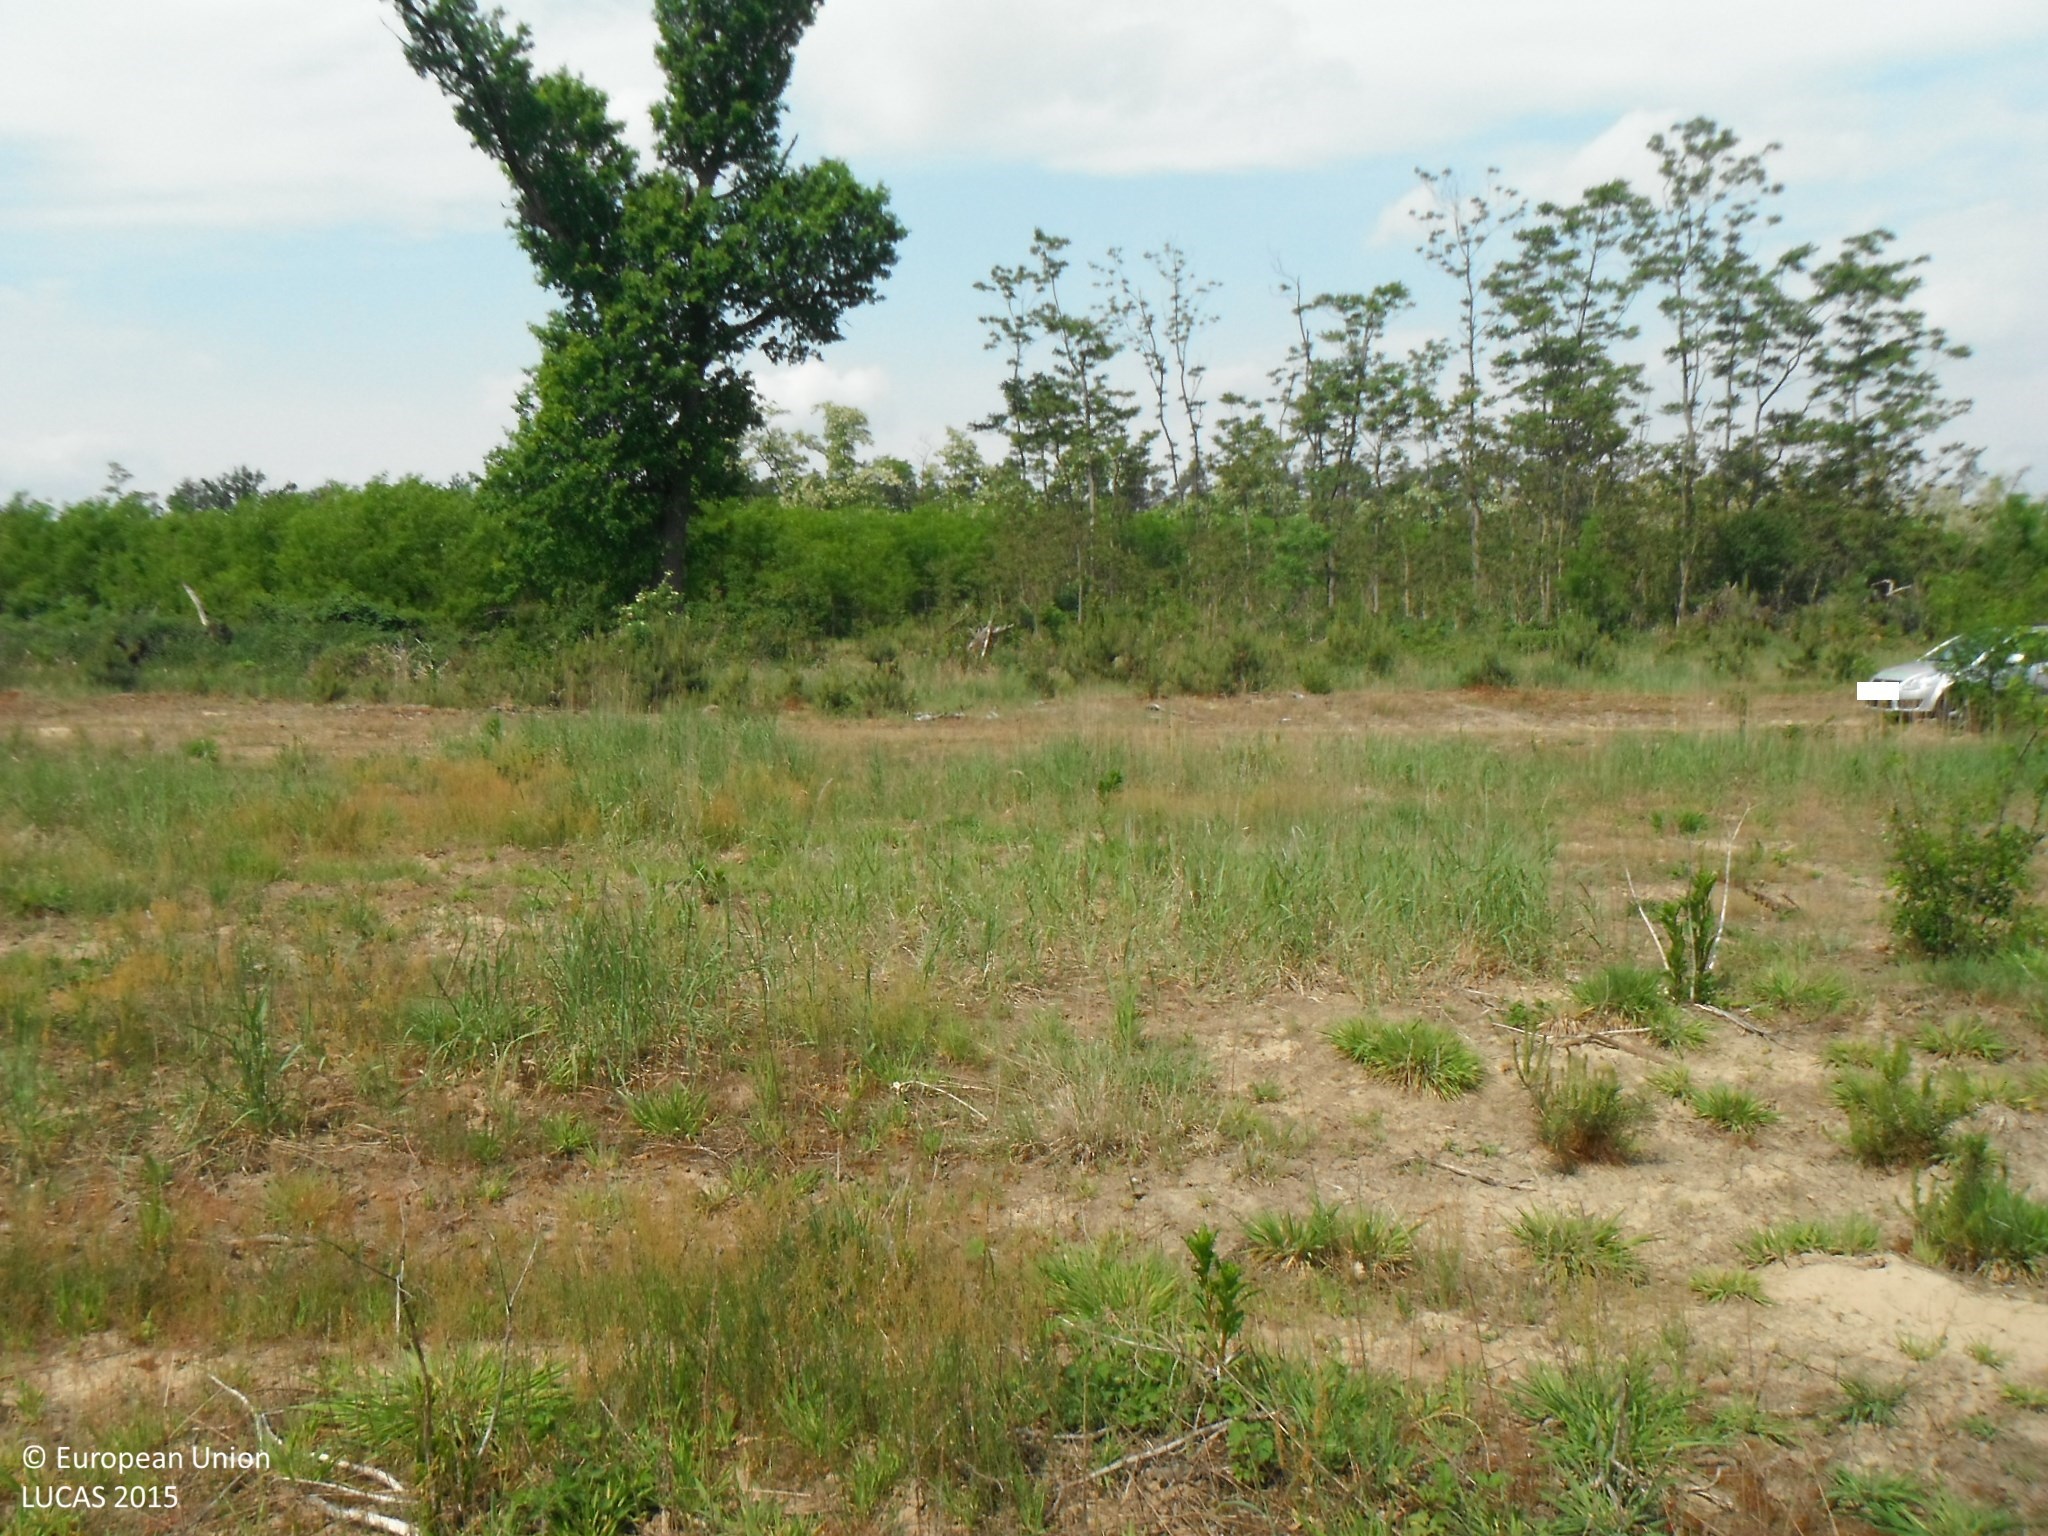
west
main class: Grassland
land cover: Spontaneously vegetated surfaces
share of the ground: > 75 %
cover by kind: herbaceous plants 80 %, unconsolidated bare surface 15 %, shrubs 5 %
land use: Forestry
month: May
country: SK
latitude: 48.4184
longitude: 16.9665
